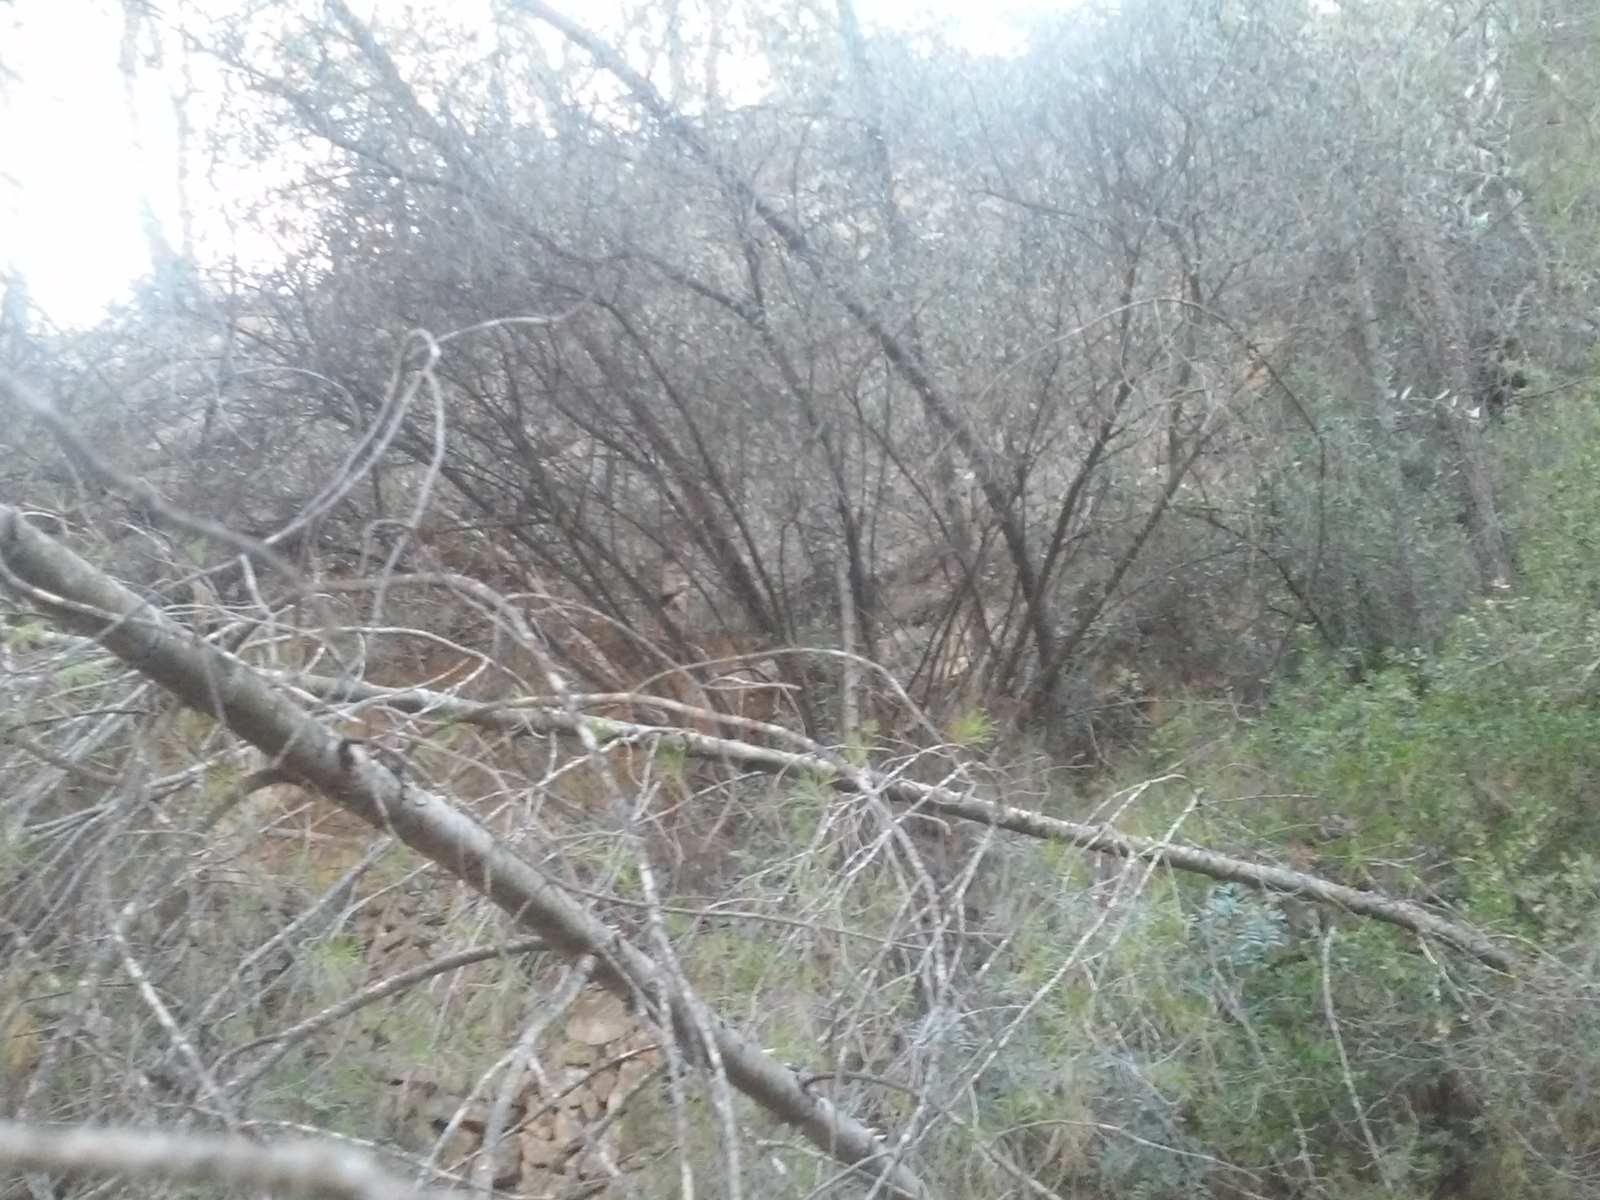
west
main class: Woodland
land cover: Pine dominated coniferous woodland
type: coniferous forest of the mediterranean region
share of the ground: 50 - 75 %
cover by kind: coniferous forest trees 50 %, shrubs 35 %, herbaceous plants 10 %, broadleaved forest trees 5 %
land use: Semi-natural and natural areas not in use
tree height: < 5 m
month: September
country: ES
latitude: 41.1672
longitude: 0.6591
